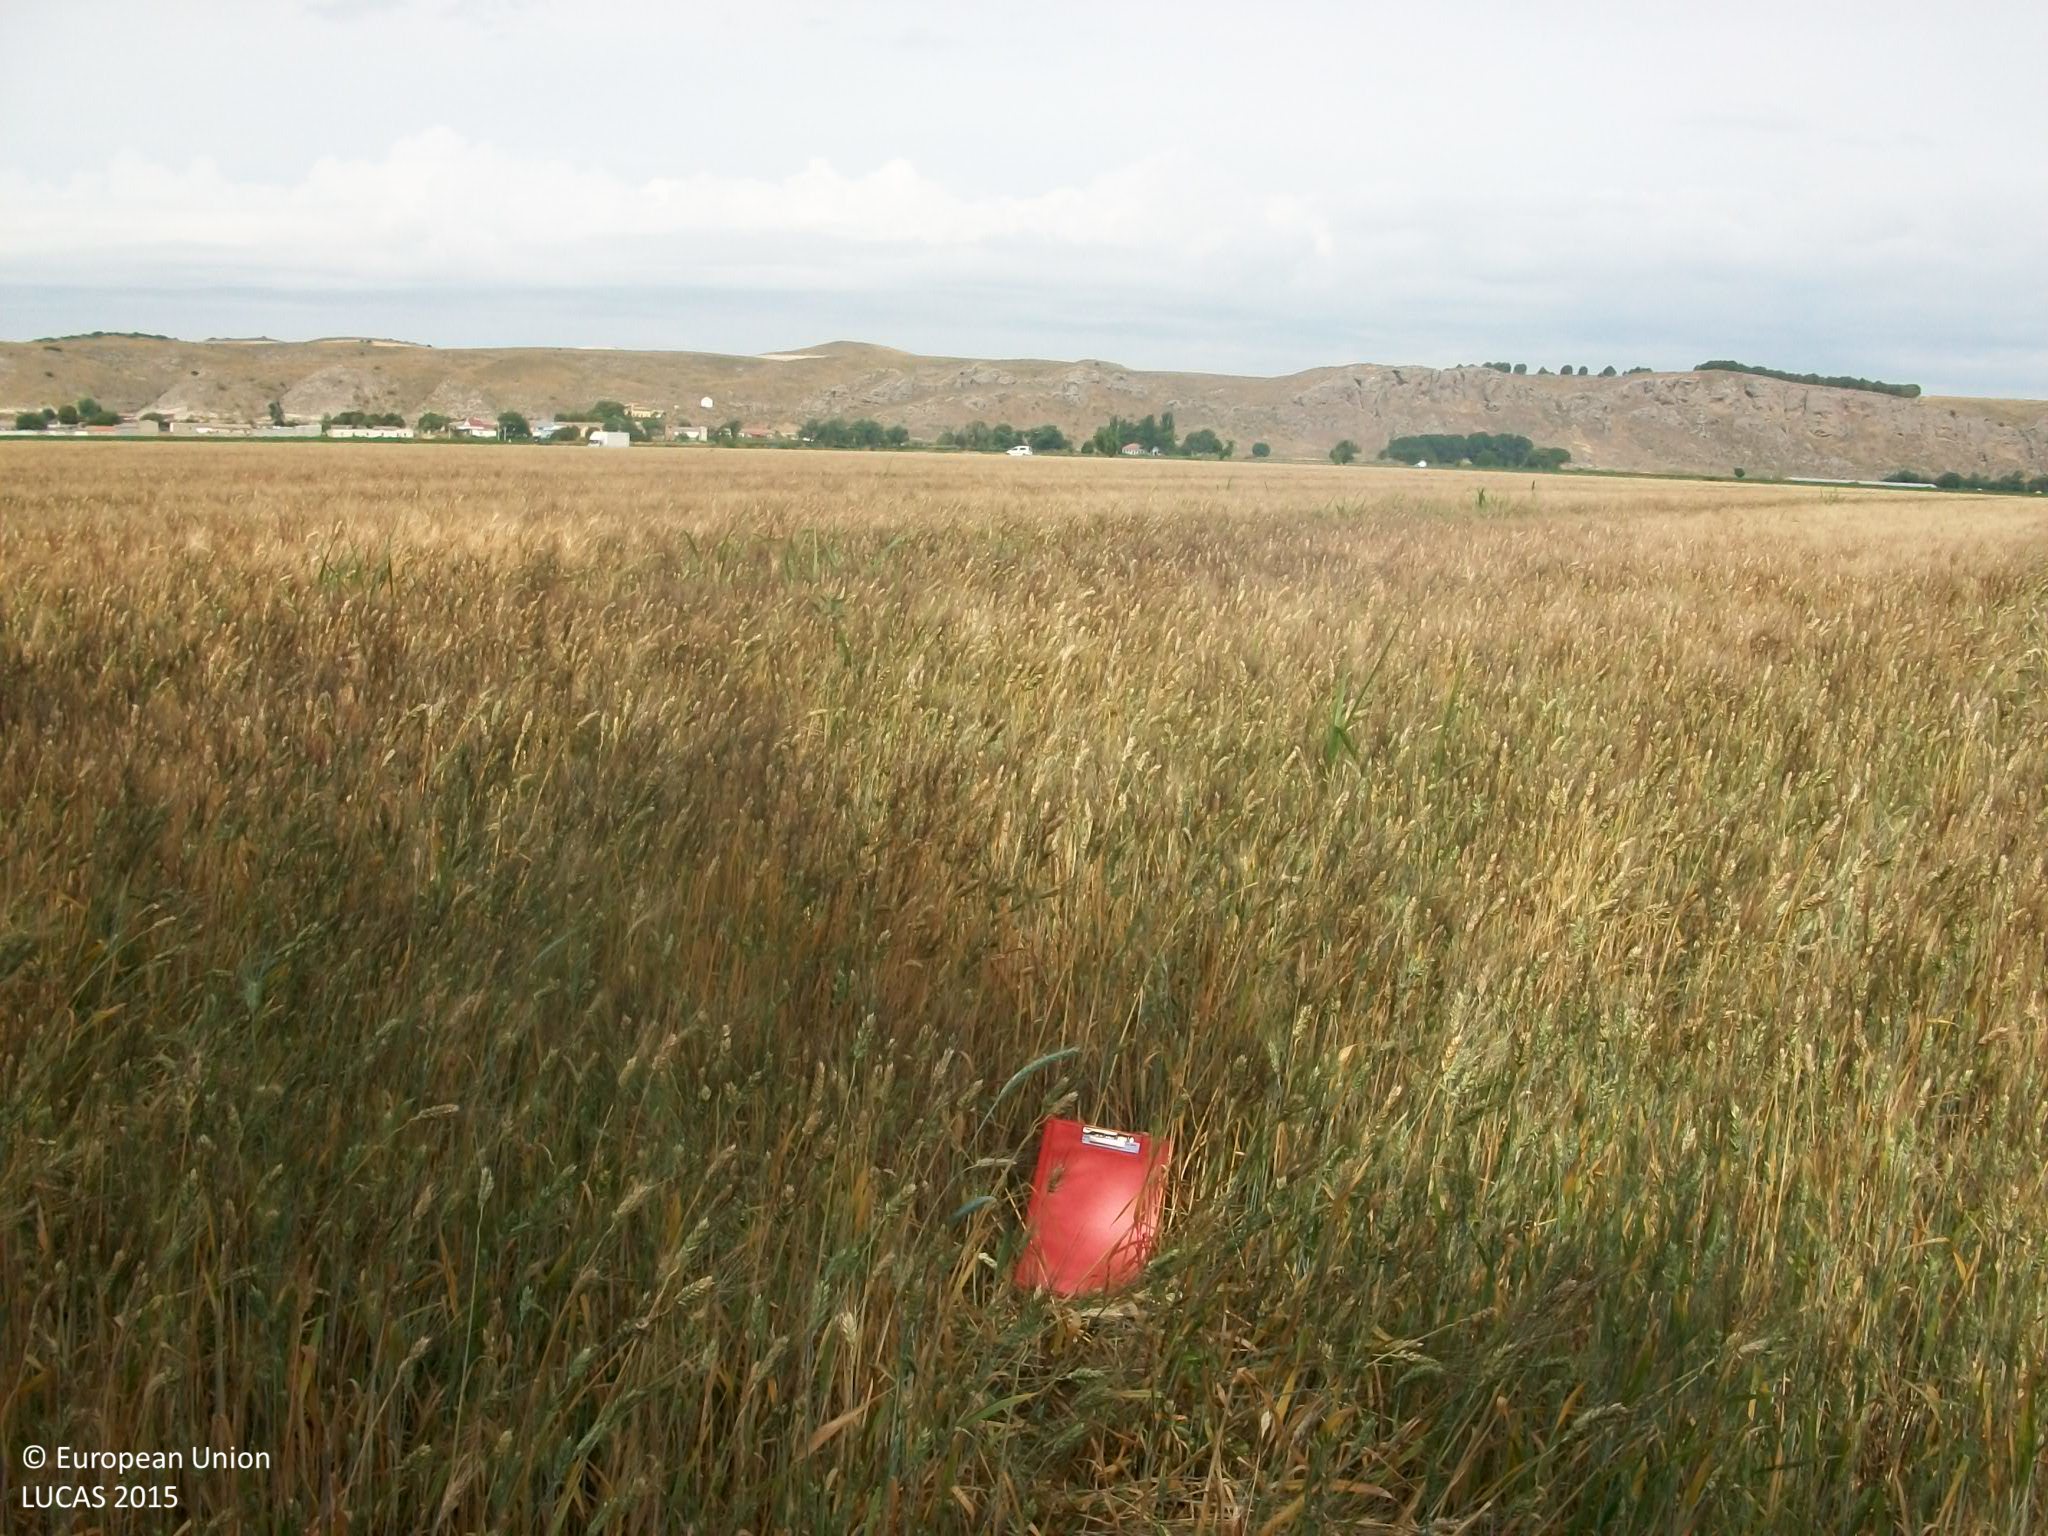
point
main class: Cropland
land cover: Common wheat
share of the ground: > 75 %
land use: Agriculture (excluding fallow land and kitchen gardens)
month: June
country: ES
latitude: 40.2576
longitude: -3.5428
